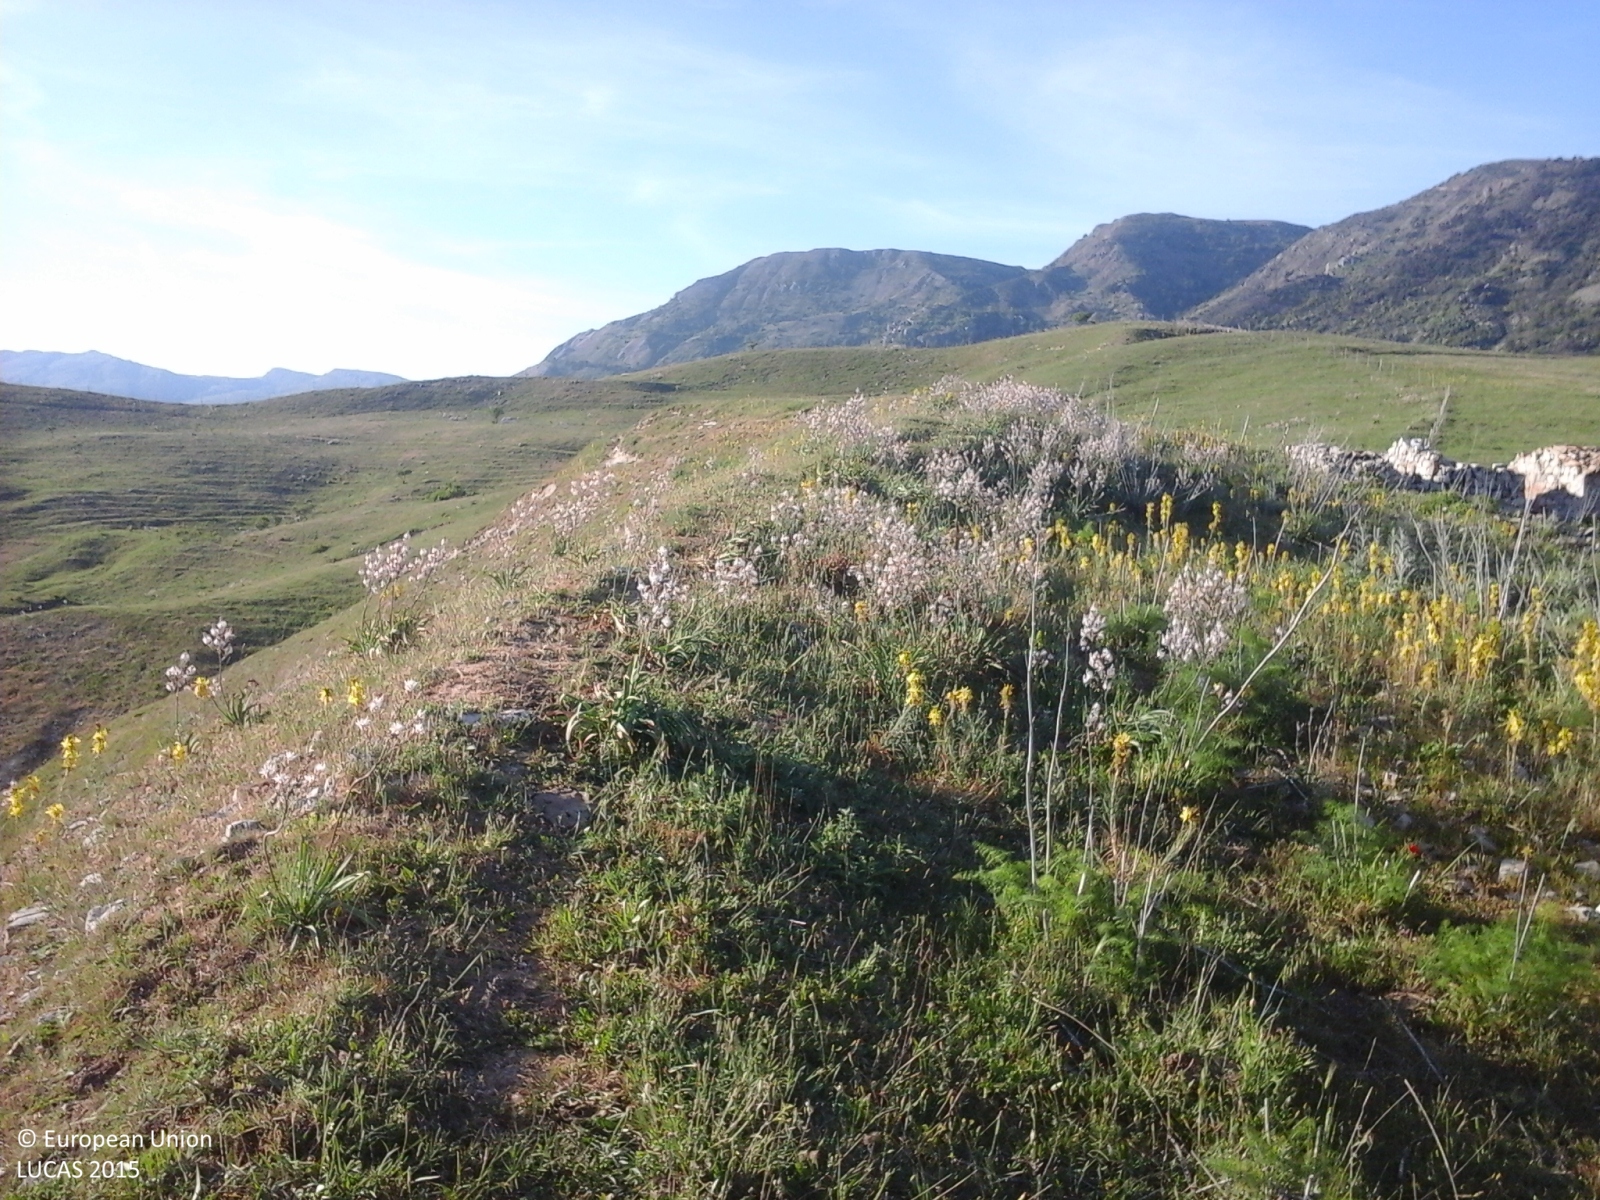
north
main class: Grassland
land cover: Grassland without tree/shrub cover
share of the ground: > 75 %
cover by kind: herbaceous plants 90 %, consolidated bare surface 5 %, unconsolidated bare surface 5 %
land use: Agriculture (excluding fallow land and kitchen gardens)
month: May
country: IT
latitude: 37.8077
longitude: 14.0261
